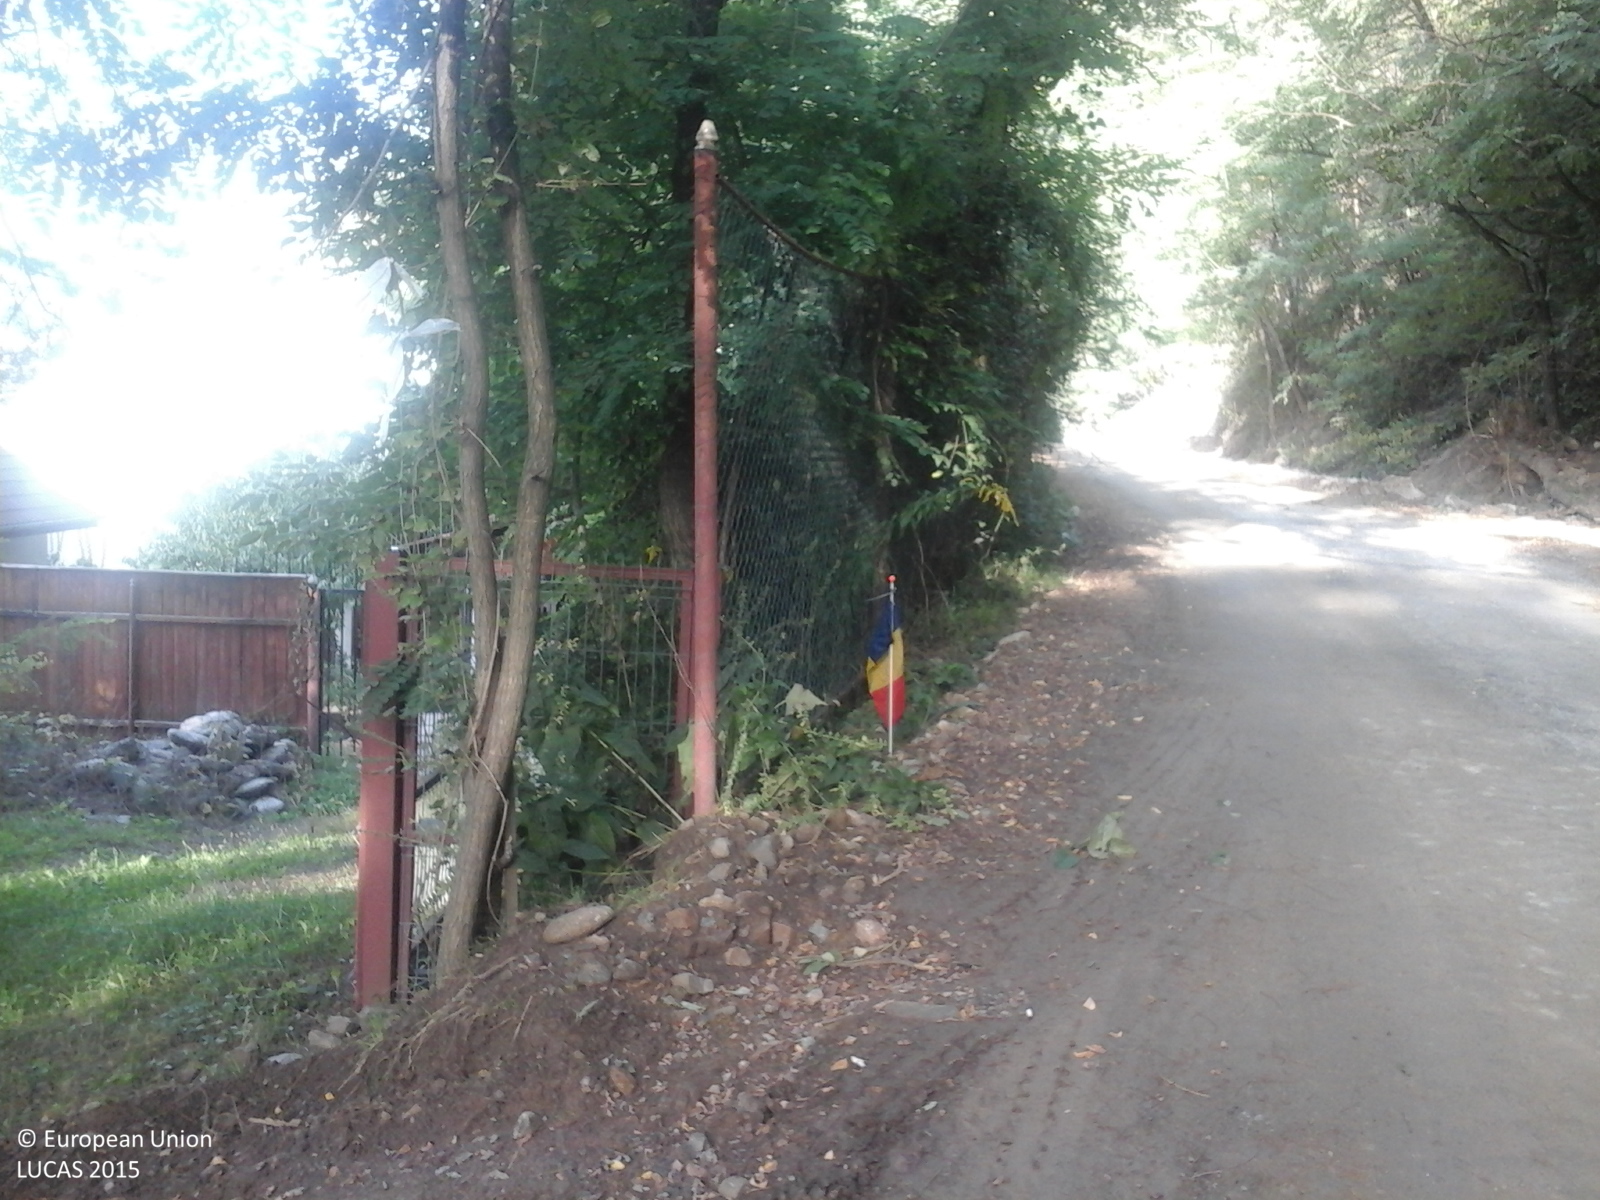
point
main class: Woodland
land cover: Broadleaved woodland
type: beech forest
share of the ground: > 75 %
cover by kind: broadleaved forest trees 100 %
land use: Forestry
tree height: > 5 m
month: September
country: RO
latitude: 46.7356
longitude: 23.3231
